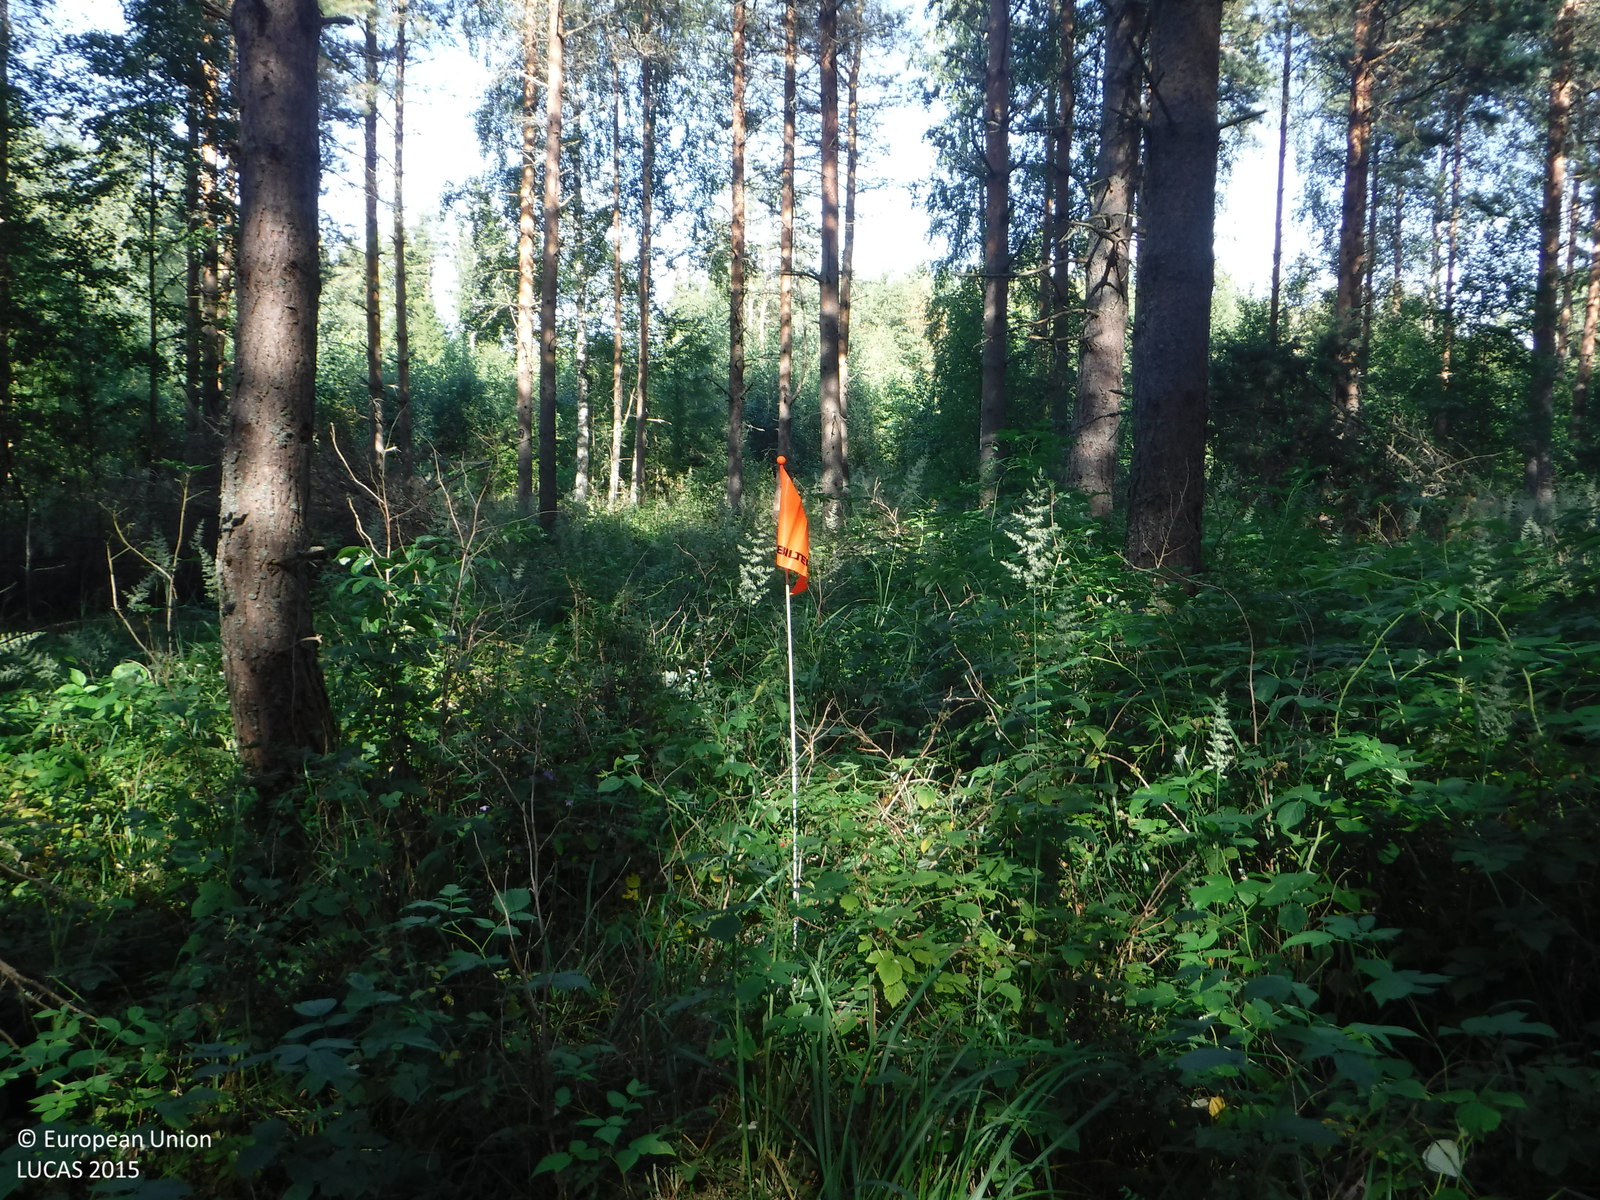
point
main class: Woodland
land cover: Pine dominated coniferous woodland
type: boreal forest
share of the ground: 50 - 75 %
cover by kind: coniferous forest trees 65 %, shrubs 30 %, herbaceous plants 5 %
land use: Forestry
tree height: > 5 m
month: August
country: FI
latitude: 61.0823
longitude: 21.4165
